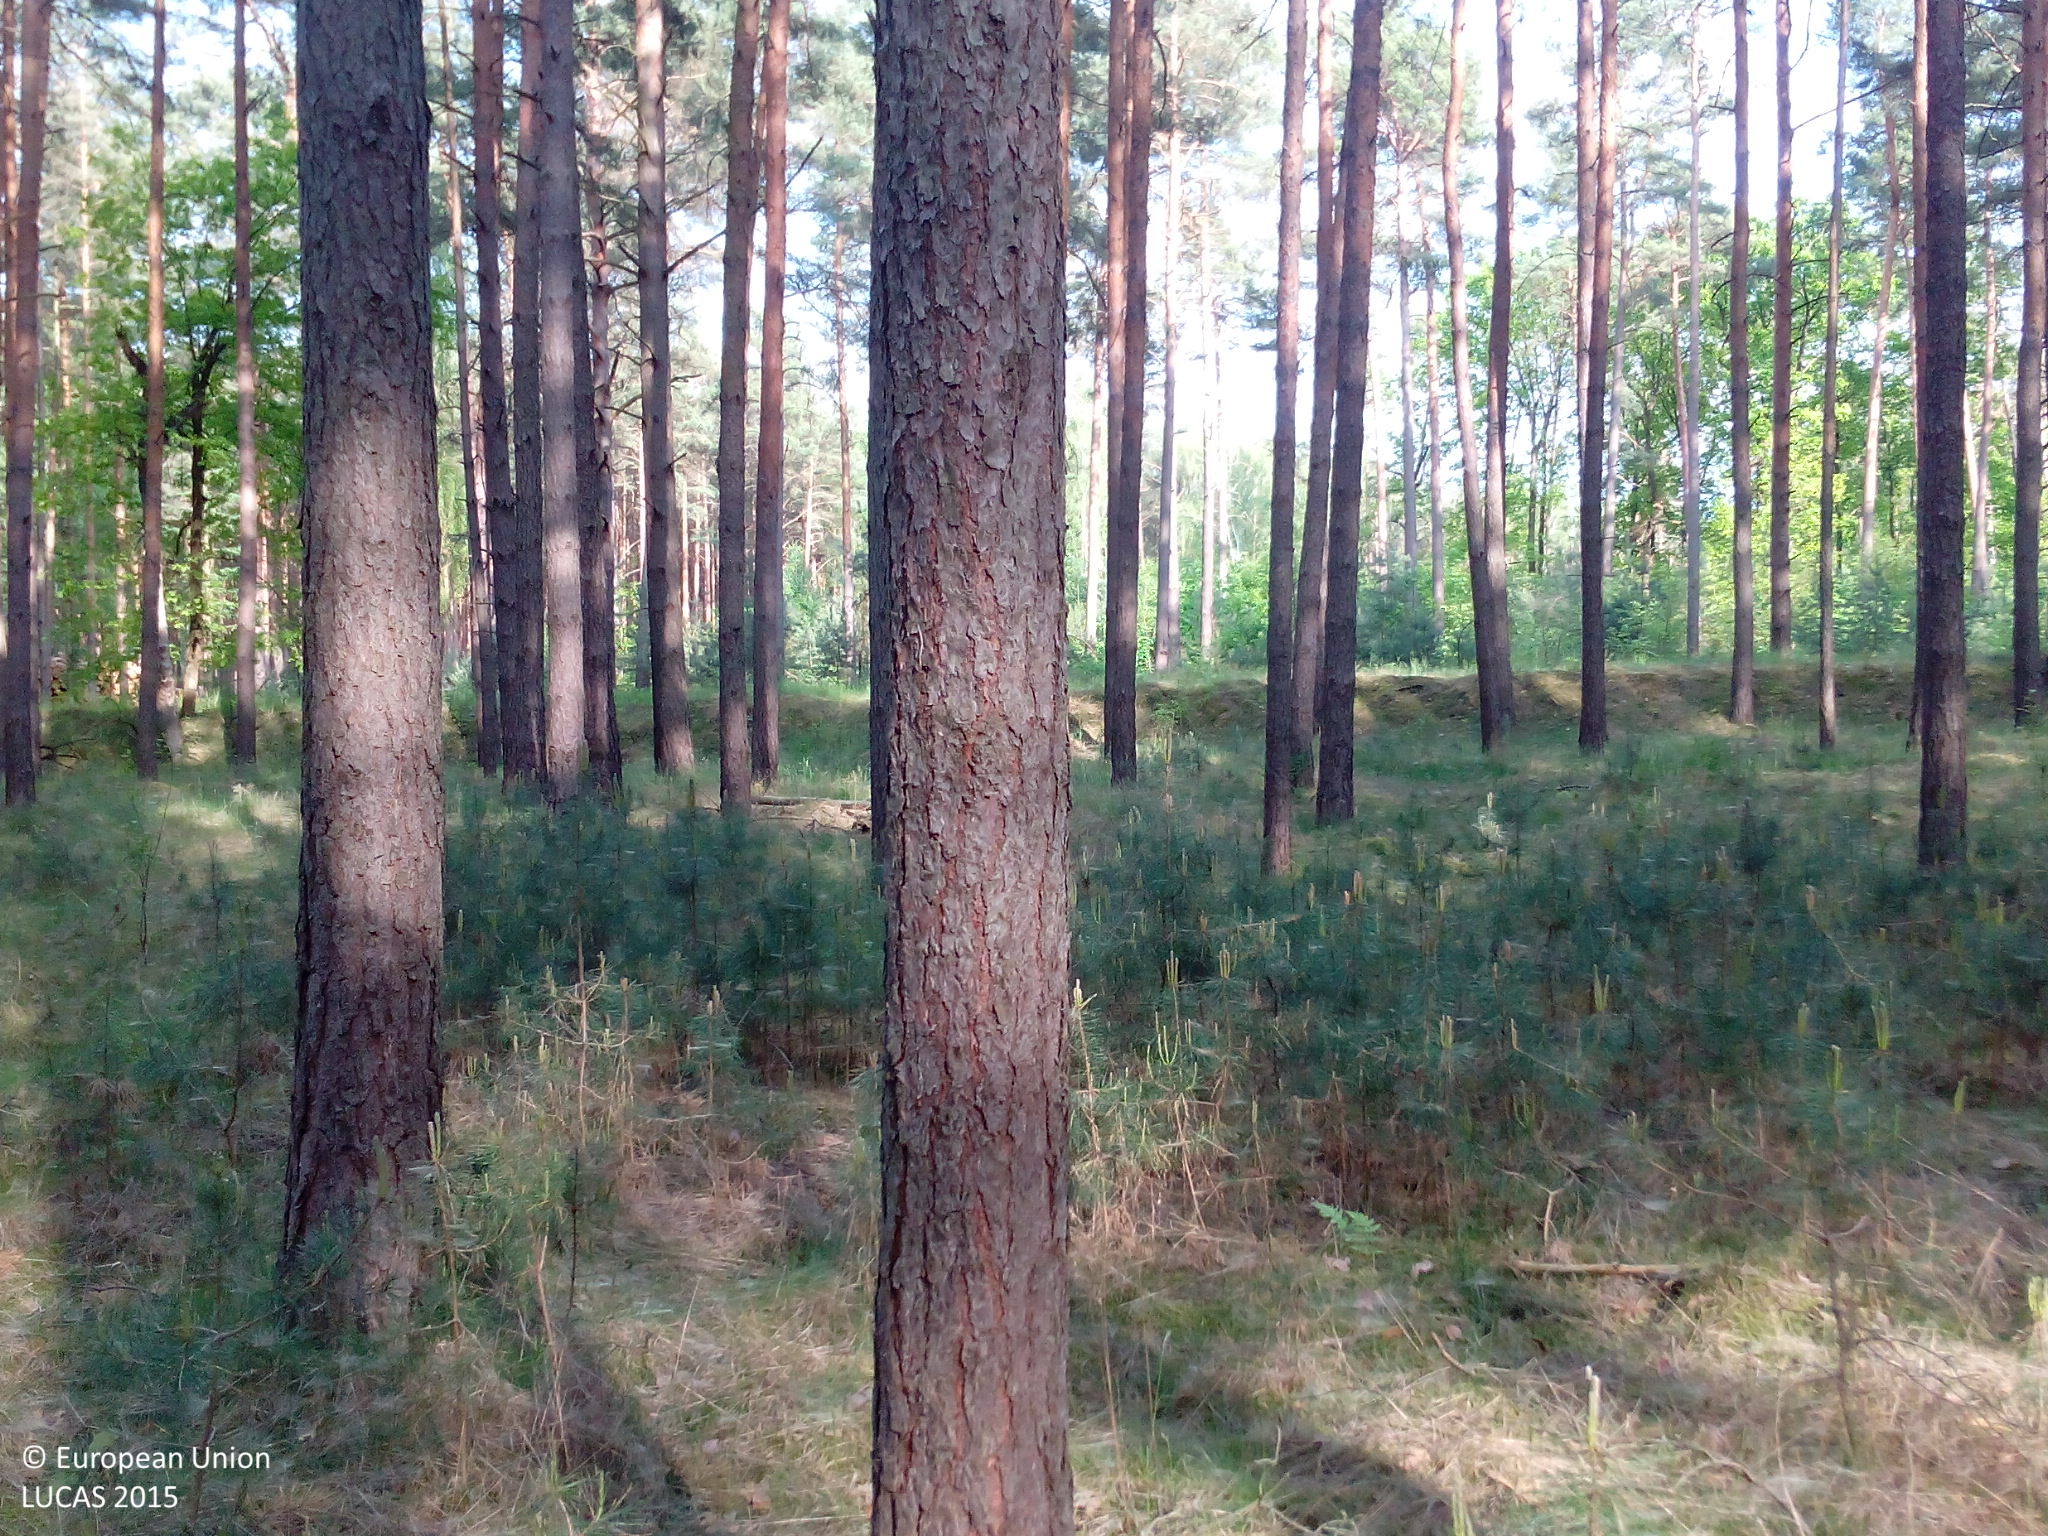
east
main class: Woodland
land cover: Pine dominated coniferous woodland
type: hemiboreal forest and nemoral coniferous forest and mixed broadleaved-coniferous forest
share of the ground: > 75 %
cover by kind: coniferous forest trees 75 %, herbaceous plants 15 %, lichens and mosses 10 %
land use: Forestry
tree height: > 5 m
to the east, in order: Pine dominated coniferous woodland; Tracks; Pine dominated coniferous woodland
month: May
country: DE
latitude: 52.1560
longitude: 13.1426
